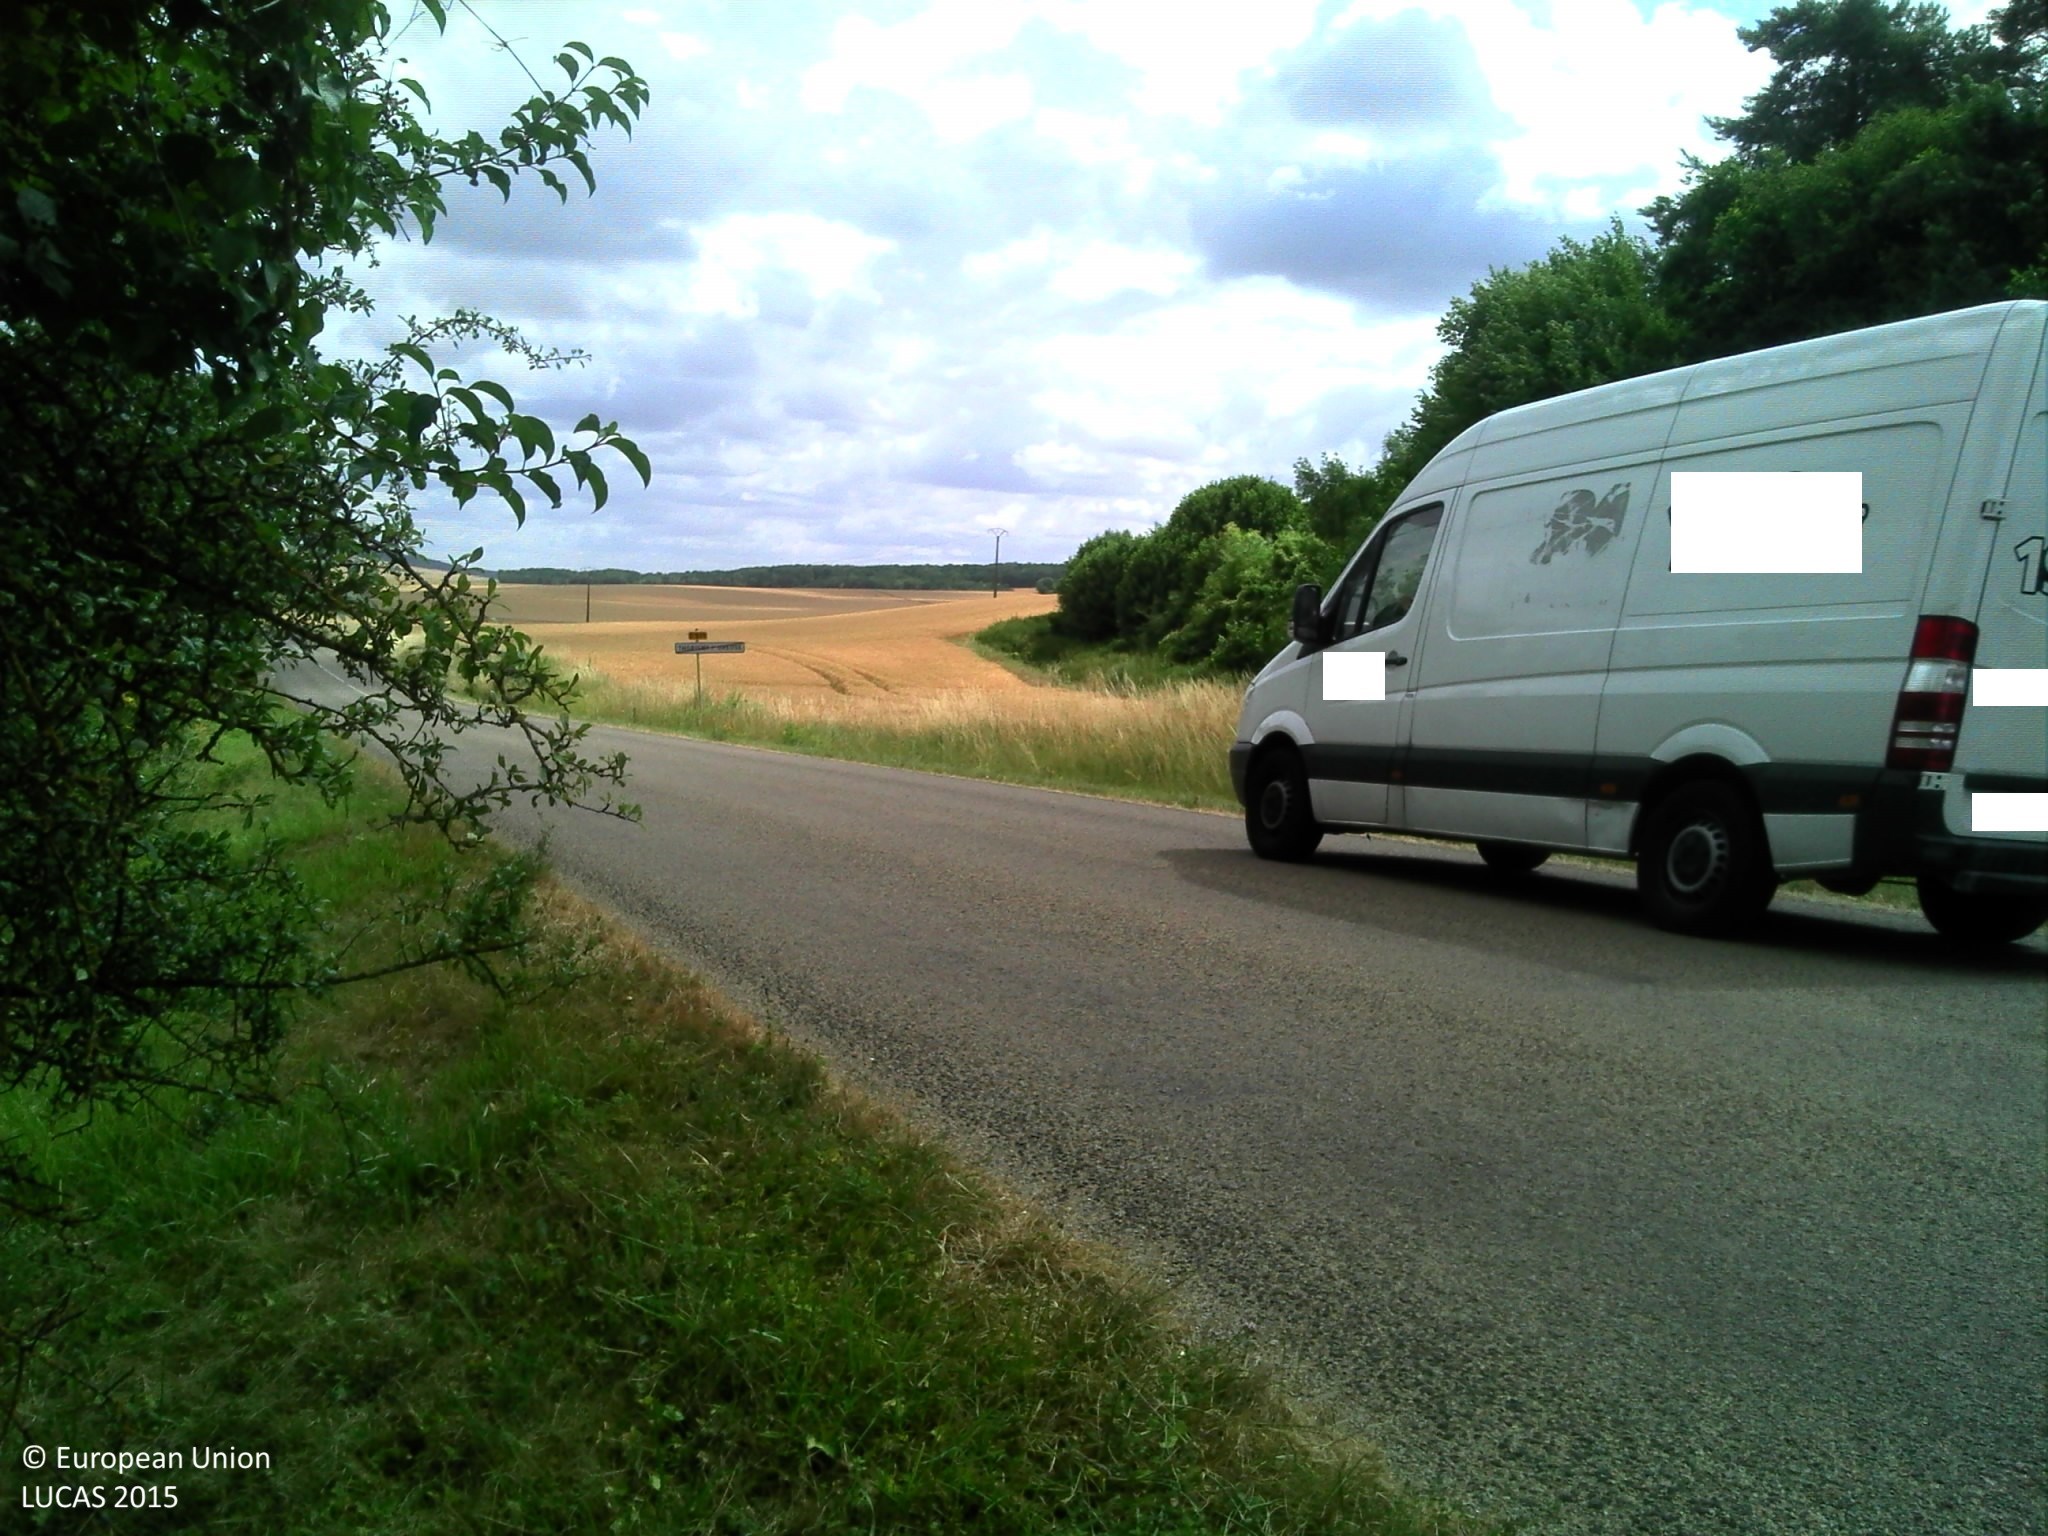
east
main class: Grassland
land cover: Grassland with sparse tree/shrub cover
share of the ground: > 75 %
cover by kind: herbaceous plants 90 %, broadleaved forest trees 5 %, shrubs 5 %
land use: Agriculture (excluding fallow land and kitchen gardens)
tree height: > 5 m
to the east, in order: Grassland with sparse tree/shrub cover; Abandoned hedges; Electric lines; Ditches and canals; Grass margins; Paved roads, cycling and walking lanes; Grass margins; Ditches and canals; Grass margins; Common wheat; Spontaneously vegetated surfaces; Common wheat; Electric lines; Common wheat
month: July
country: FR
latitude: 48.2967
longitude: 3.4023
